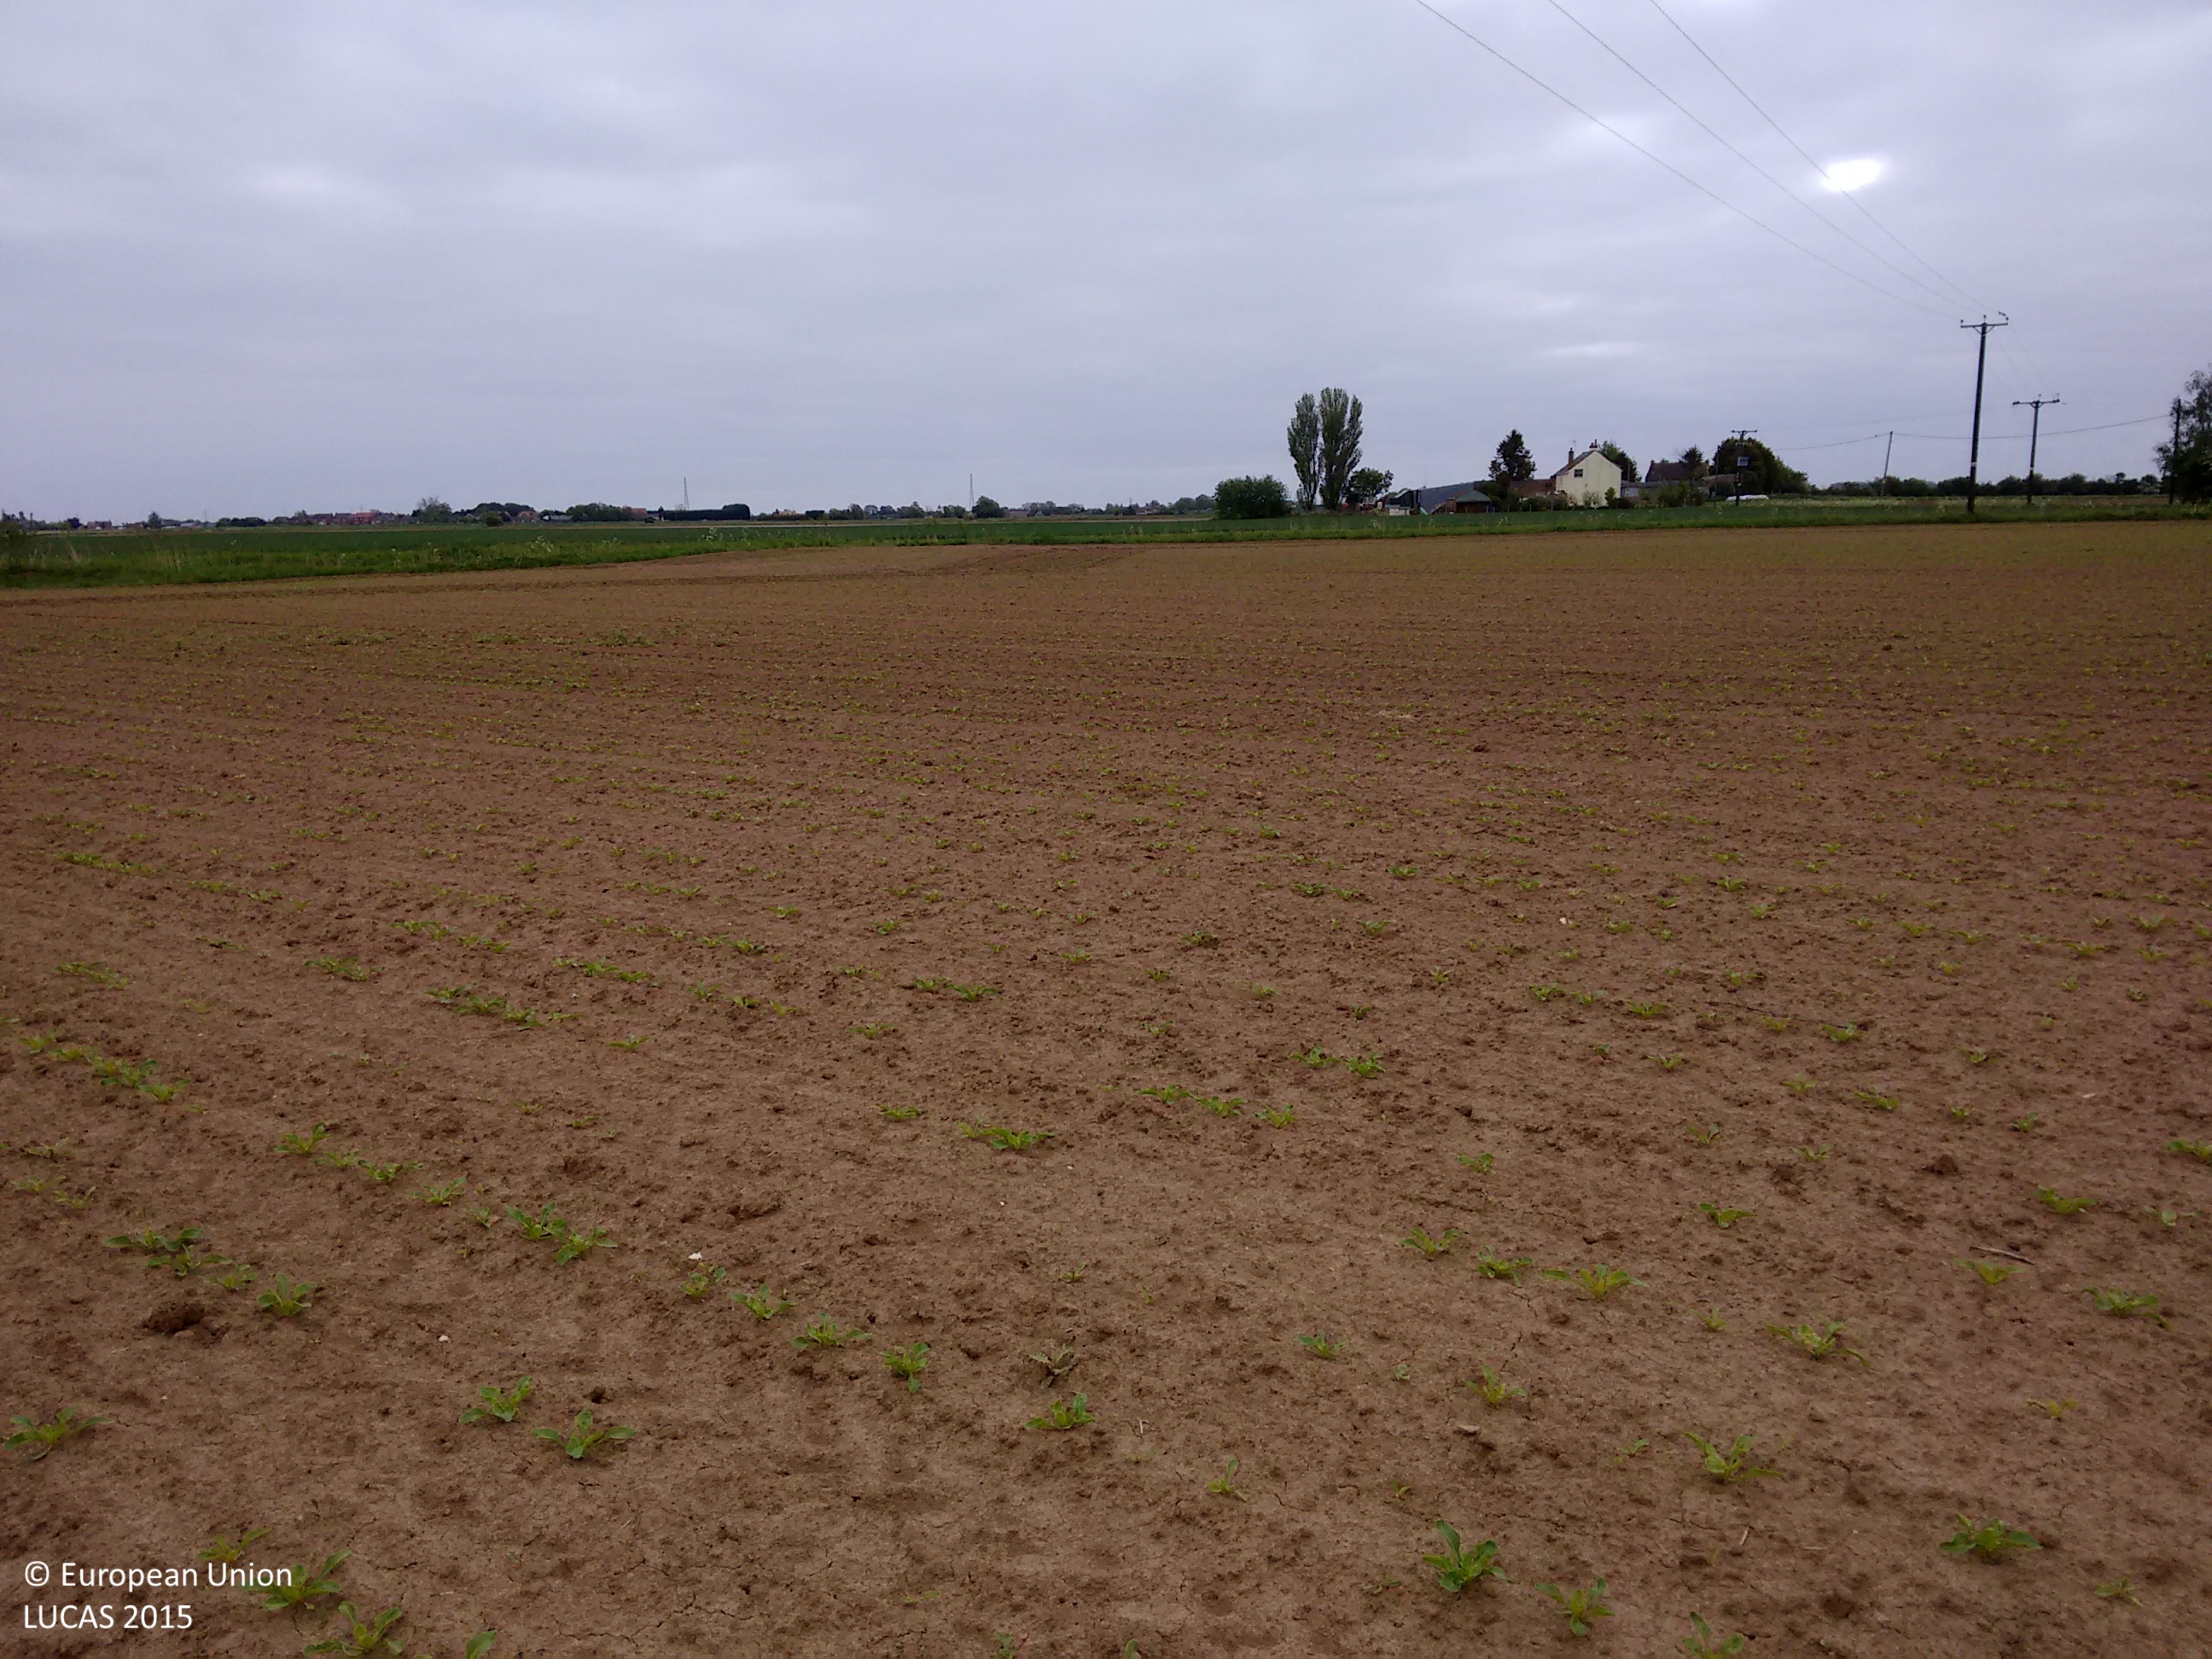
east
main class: Cropland
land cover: Other fresh vegetables
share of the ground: < 10 %
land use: Agriculture (excluding fallow land and kitchen gardens)
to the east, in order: Other fresh vegetables; Electric lines; Other fresh vegetables; Grass margins; Ditches and canals; Grass margins; Tracks; Common wheat; Other bare soil
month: May
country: GB
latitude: 52.8731
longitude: -0.0614
